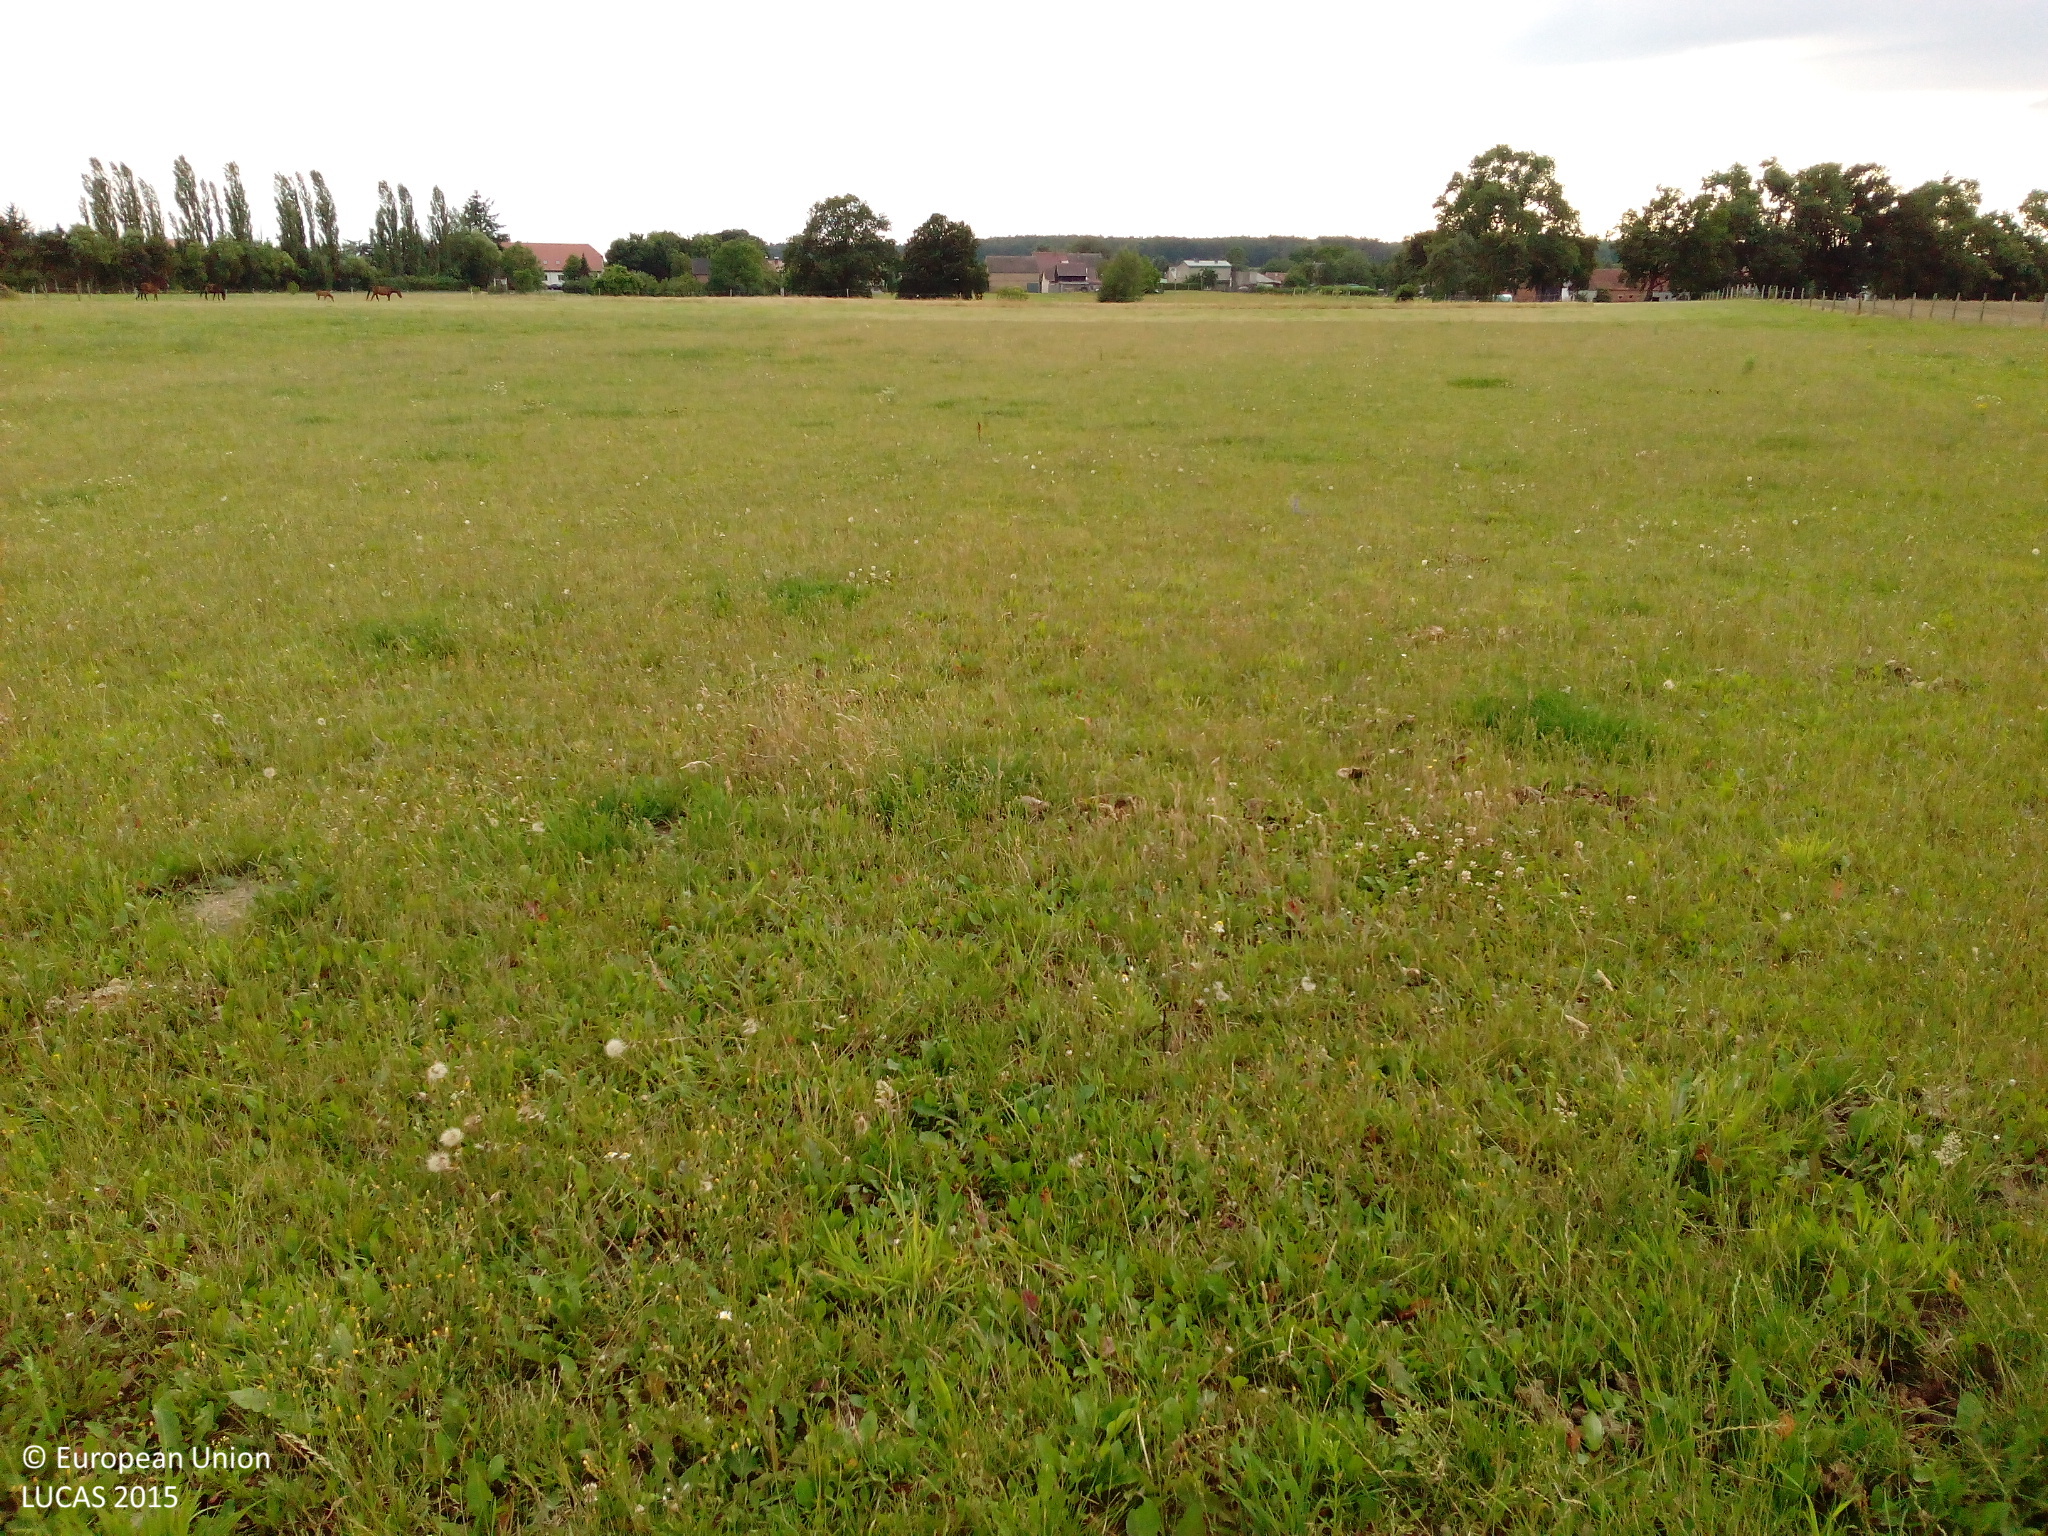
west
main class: Grassland
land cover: Grassland without tree/shrub cover
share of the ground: > 75 %
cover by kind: herbaceous plants 100 %
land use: Agriculture (excluding fallow land and kitchen gardens)
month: July
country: DE
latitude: 52.9479
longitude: 12.3360
